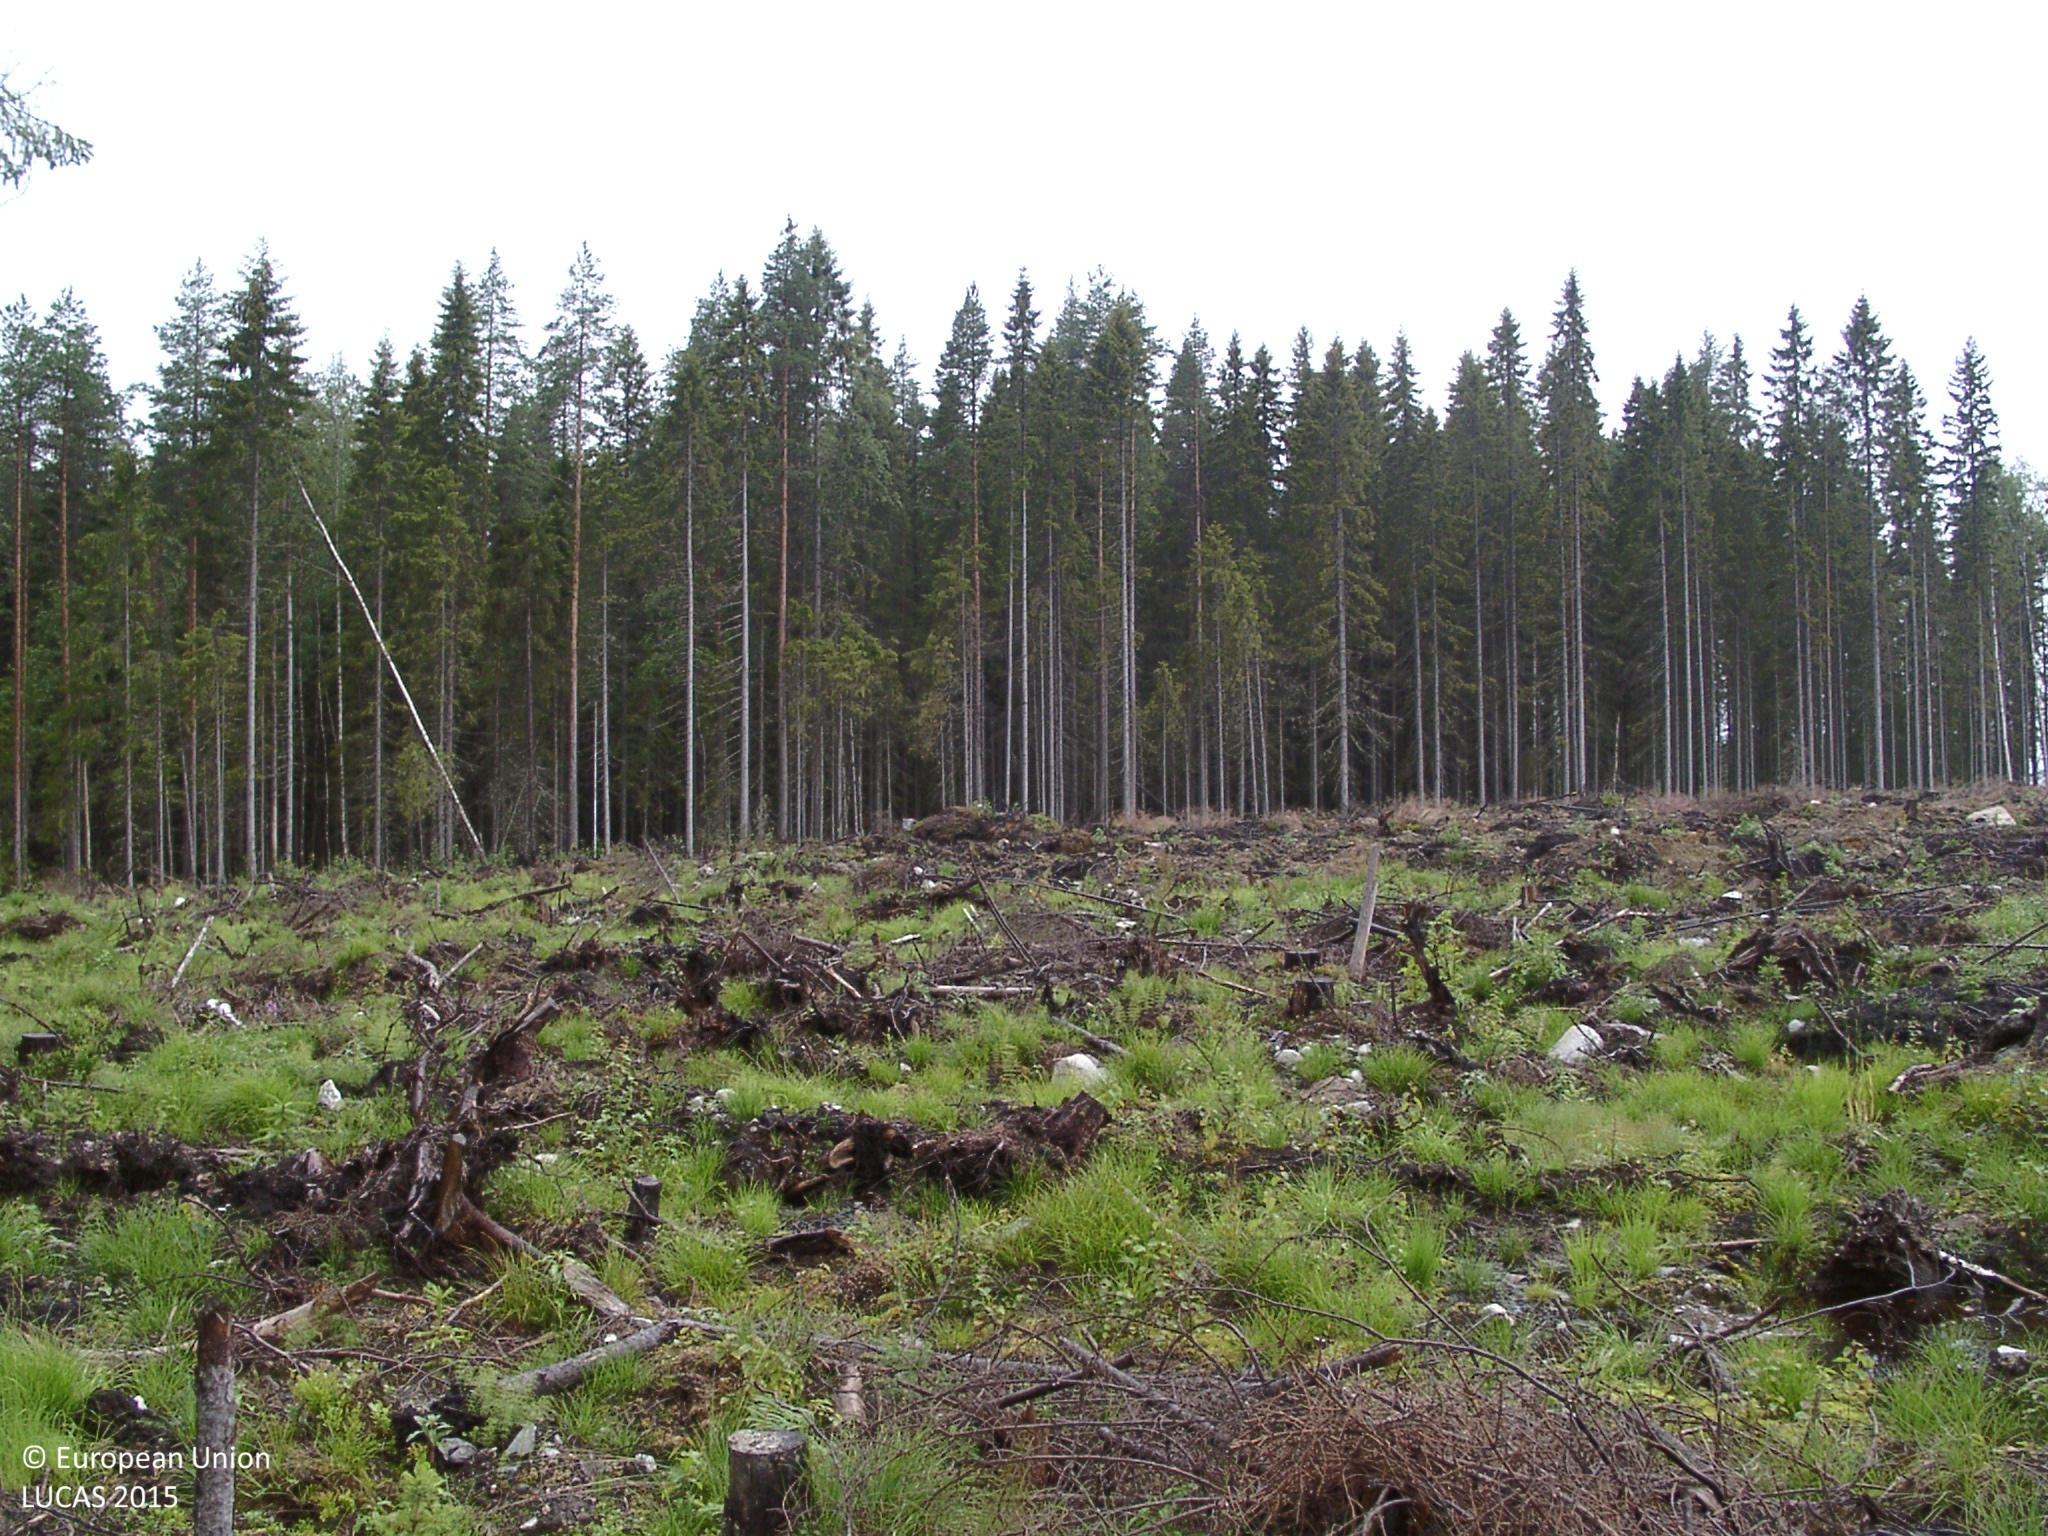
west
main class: Grassland
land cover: Grassland with sparse tree/shrub cover
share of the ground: 25 - 50 %
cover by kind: herbaceous plants 25 %, unconsolidated bare surface 25 %, lichens and mosses 10 %, broadleaved forest trees 5 %
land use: Forestry
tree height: < 5 m
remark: Nursery
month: August
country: FI
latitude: 62.8128
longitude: 24.6264
